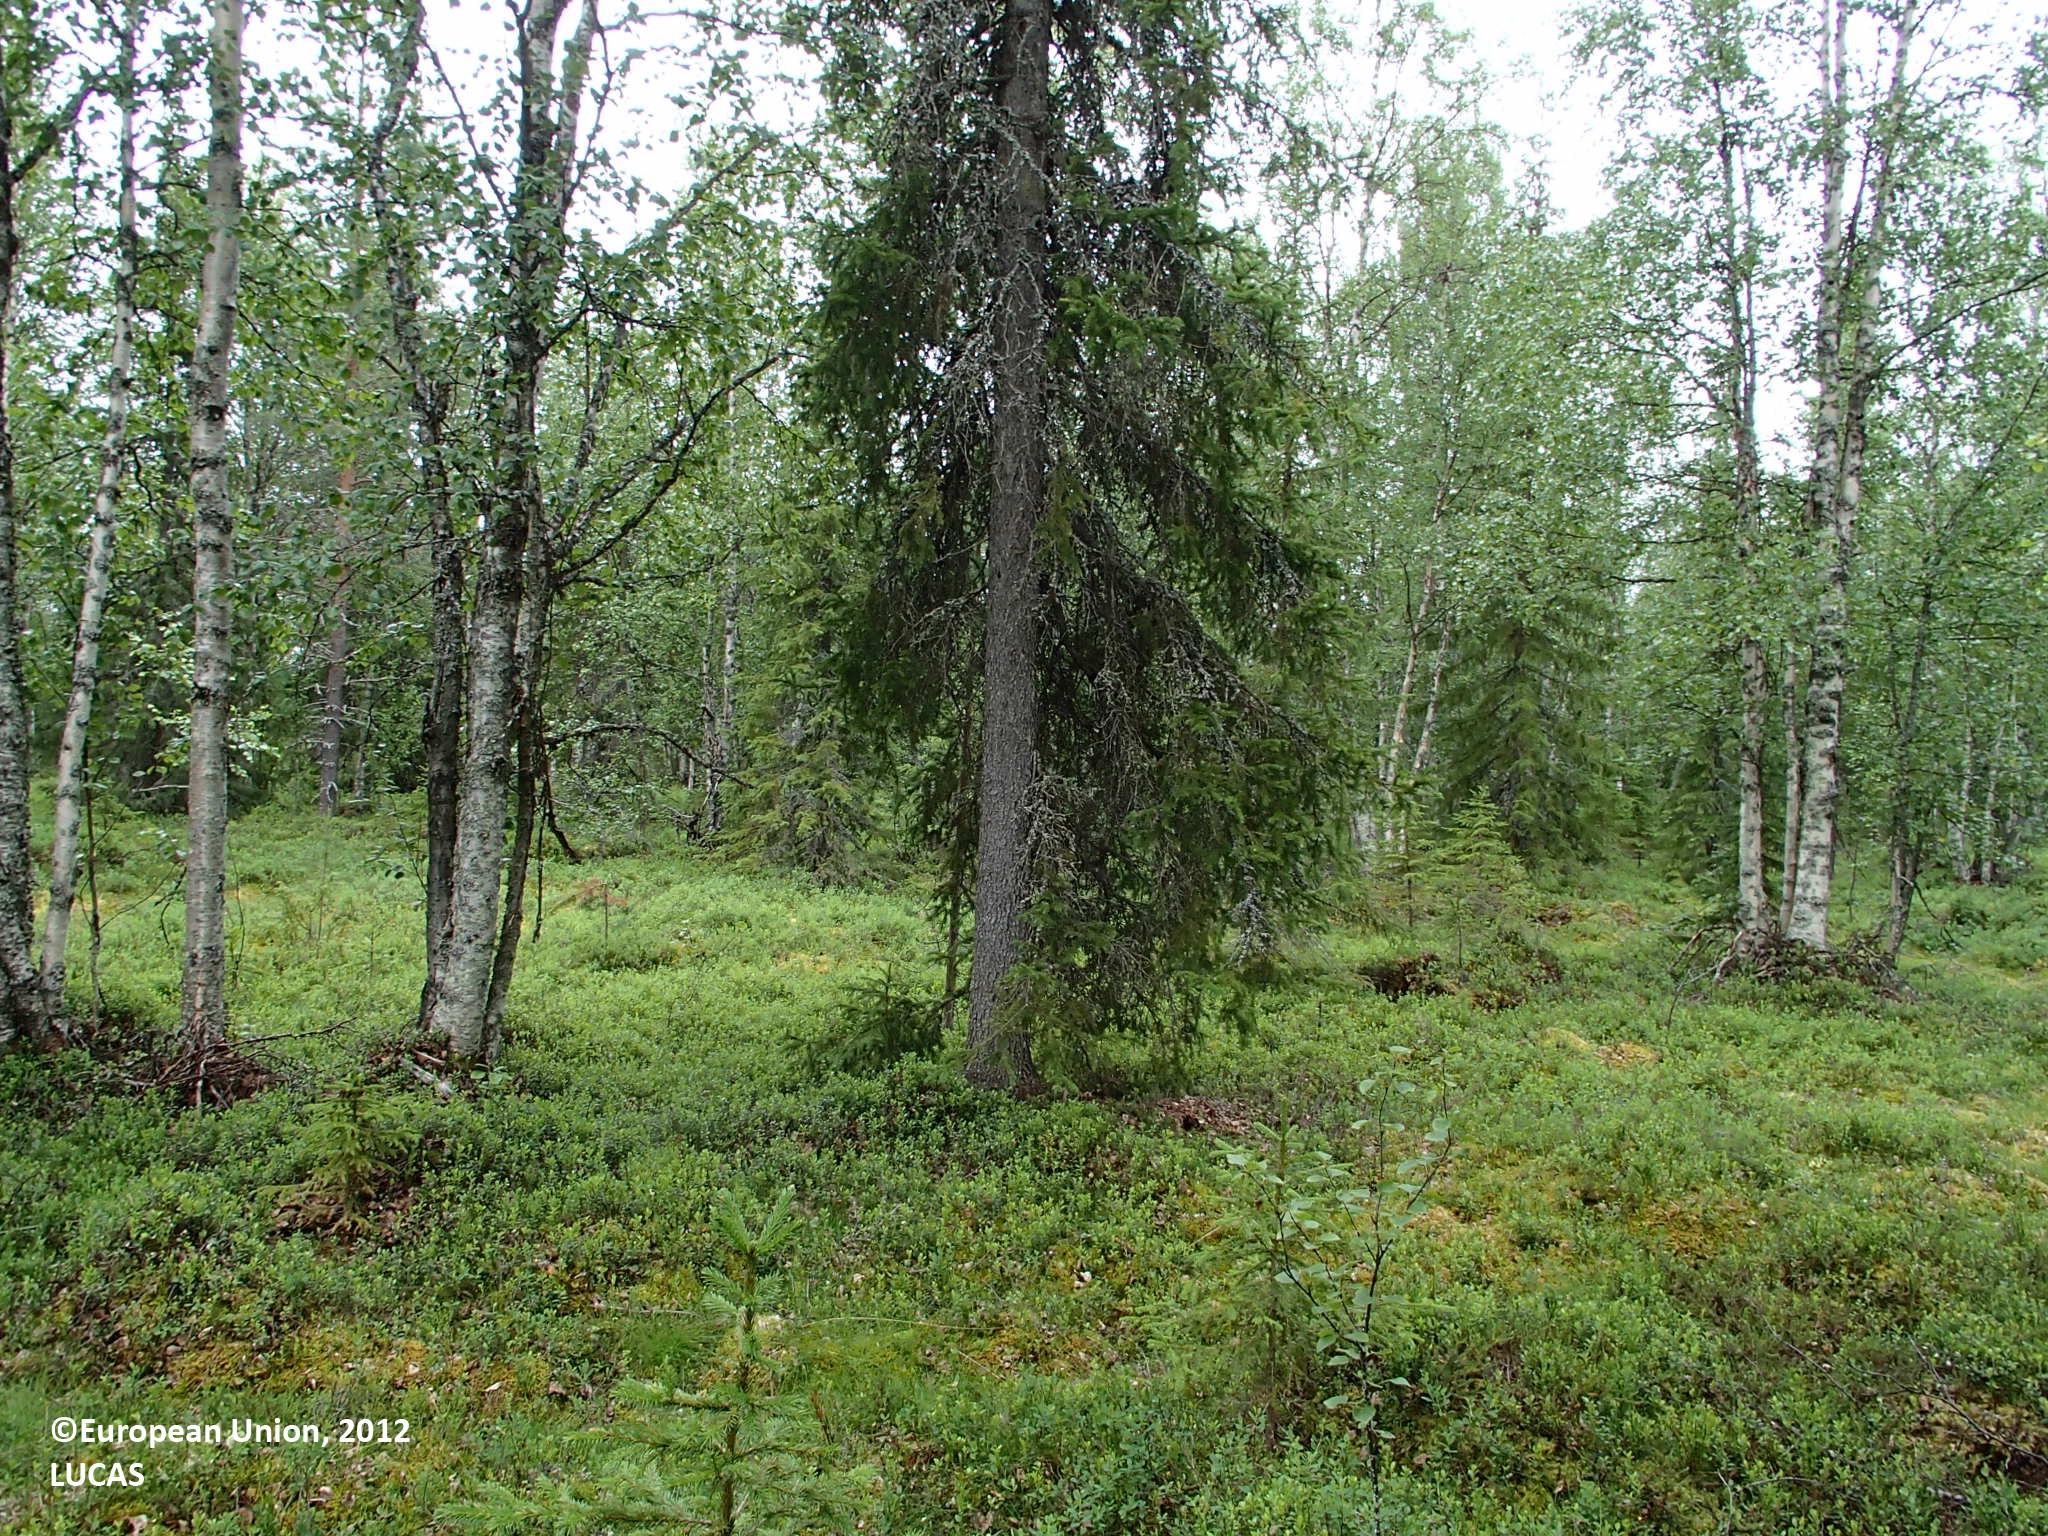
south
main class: Woodland
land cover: Other mixed woodland
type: boreal forest
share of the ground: > 75 %
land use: Forestry
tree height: > 5 m
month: July
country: FI
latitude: 67.0144
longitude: 25.5474
